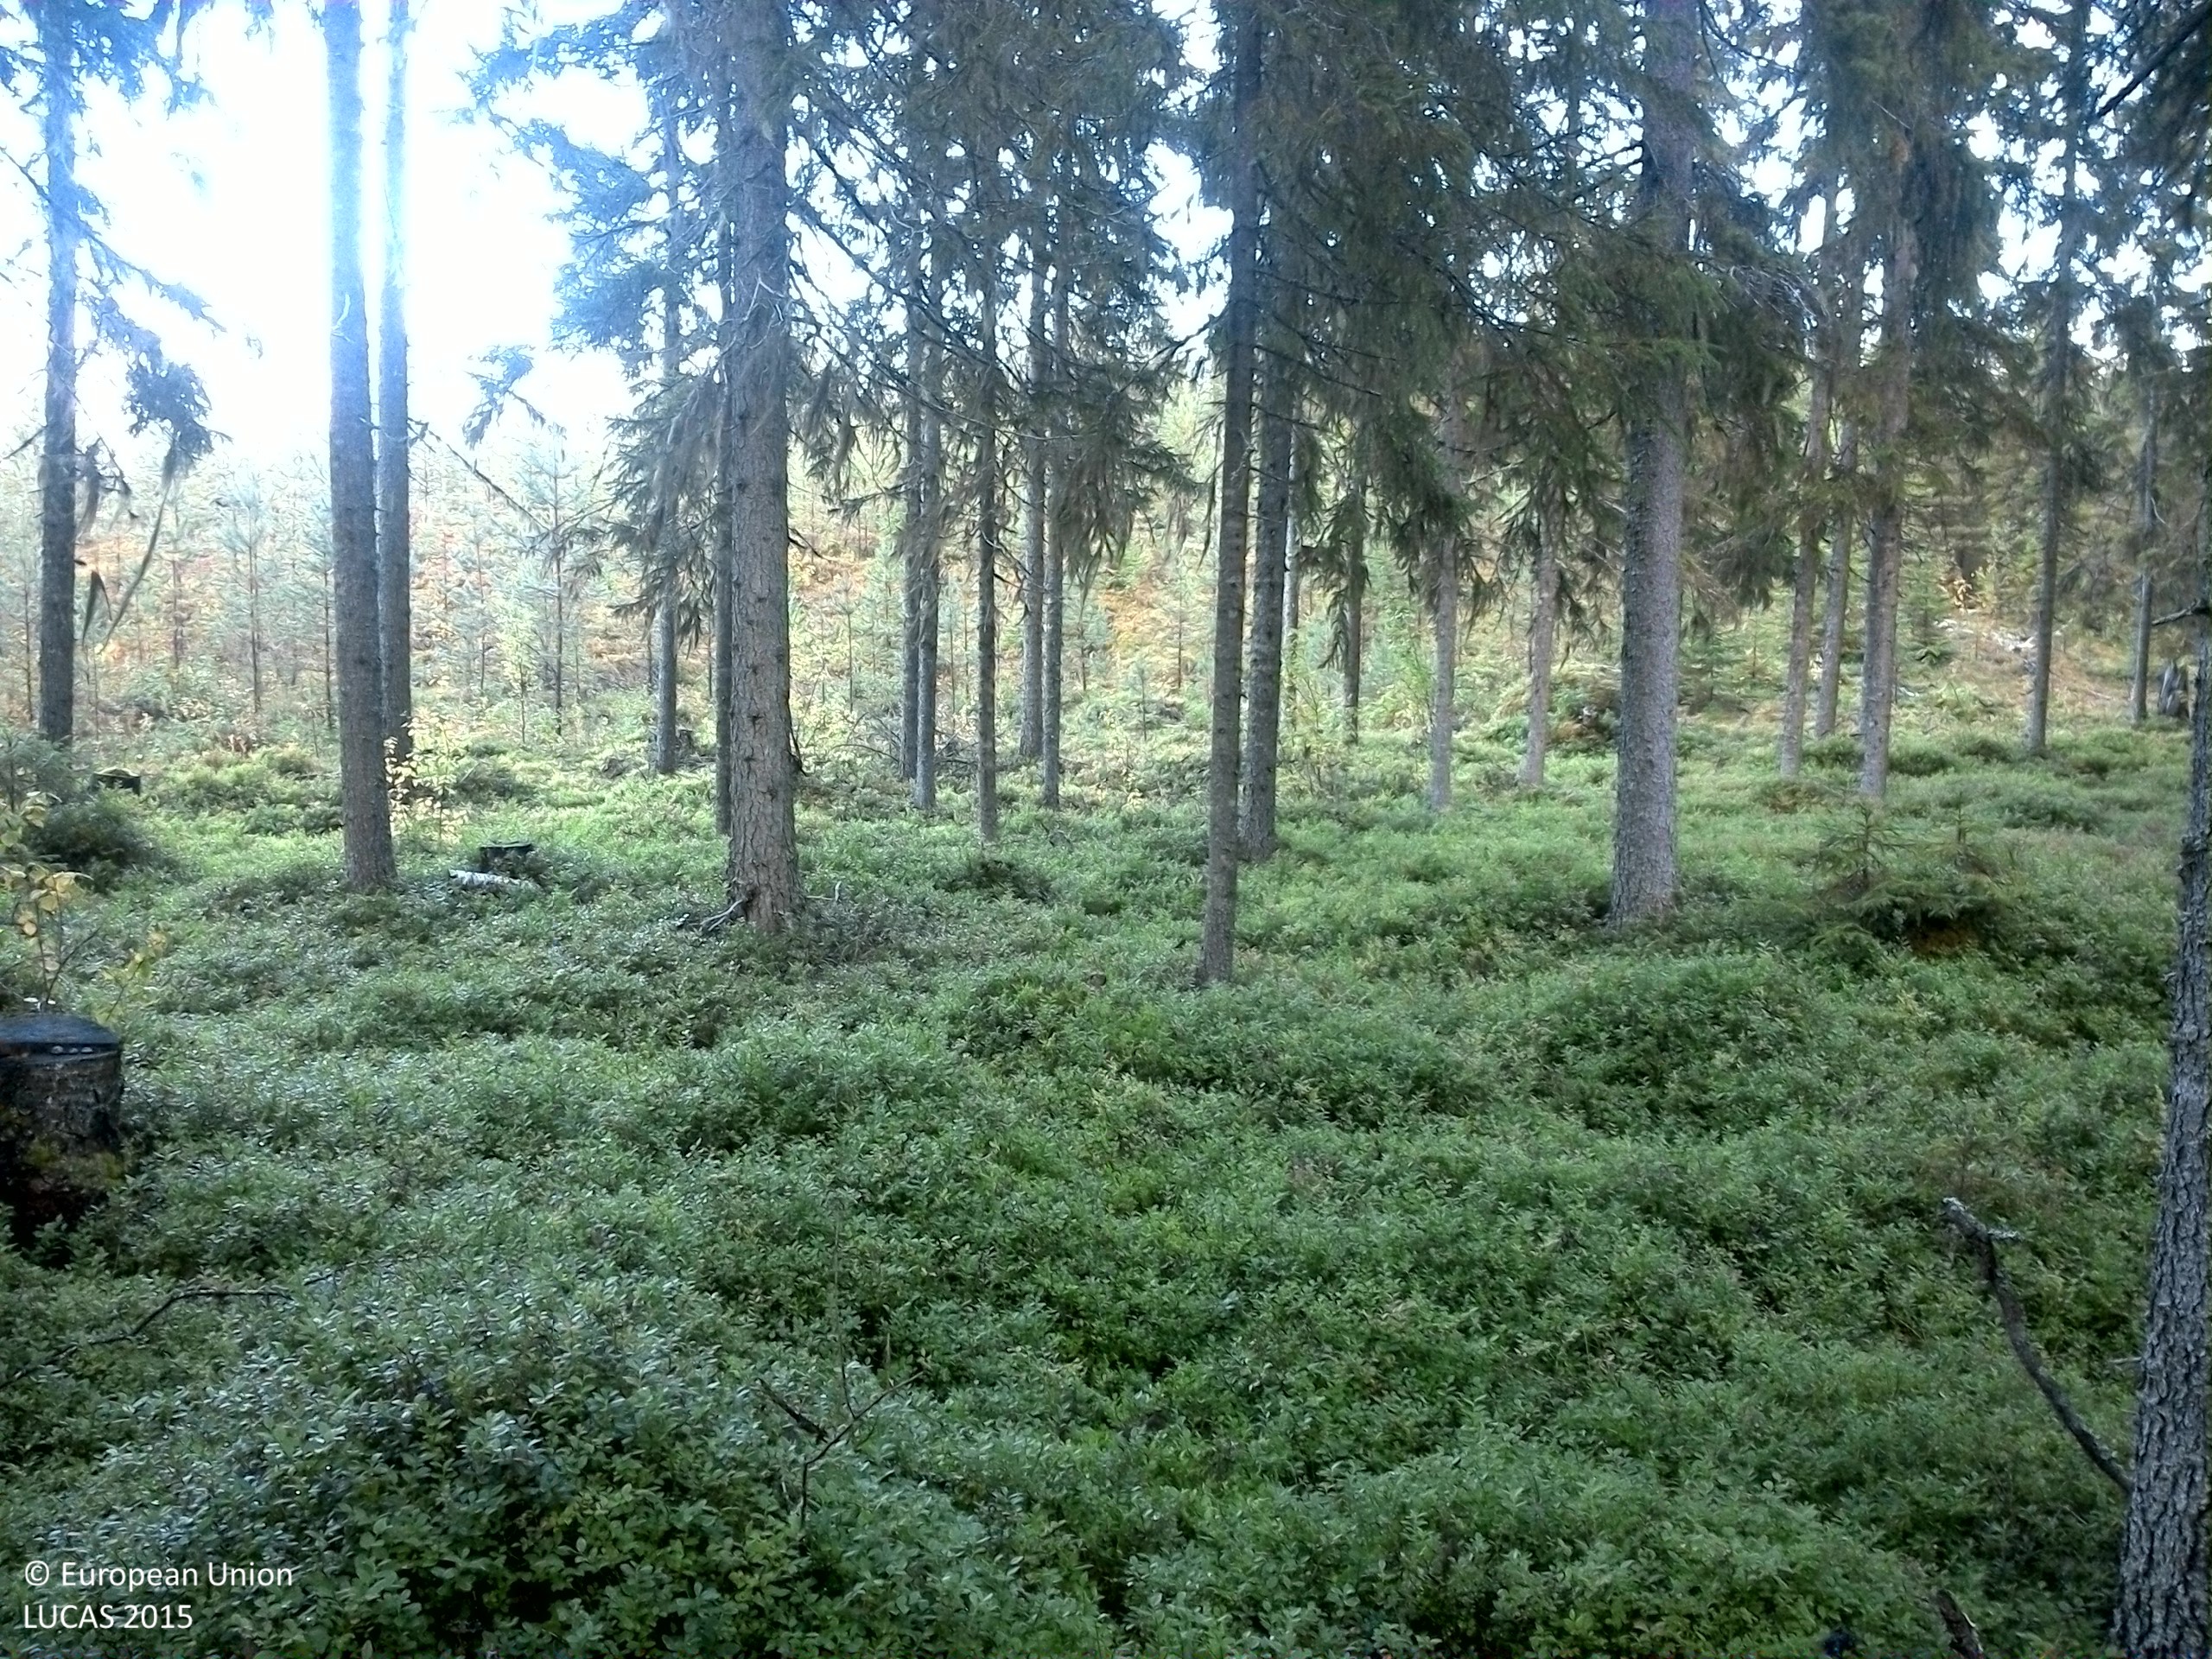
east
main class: Woodland
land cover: Spruce dominated coniferous woodland
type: boreal forest
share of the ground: 25 - 50 %
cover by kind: shrubs 50 %, coniferous forest trees 40 %, broadleaved forest trees 5 %, lichens and mosses 5 %
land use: Forestry
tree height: > 5 m
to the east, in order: Spruce dominated coniferous woodland; Pine dominated coniferous woodland; Spruce dominated mixed woodland; Pine dominated coniferous woodland
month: September
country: SE
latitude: 63.7683
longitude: 16.2385
